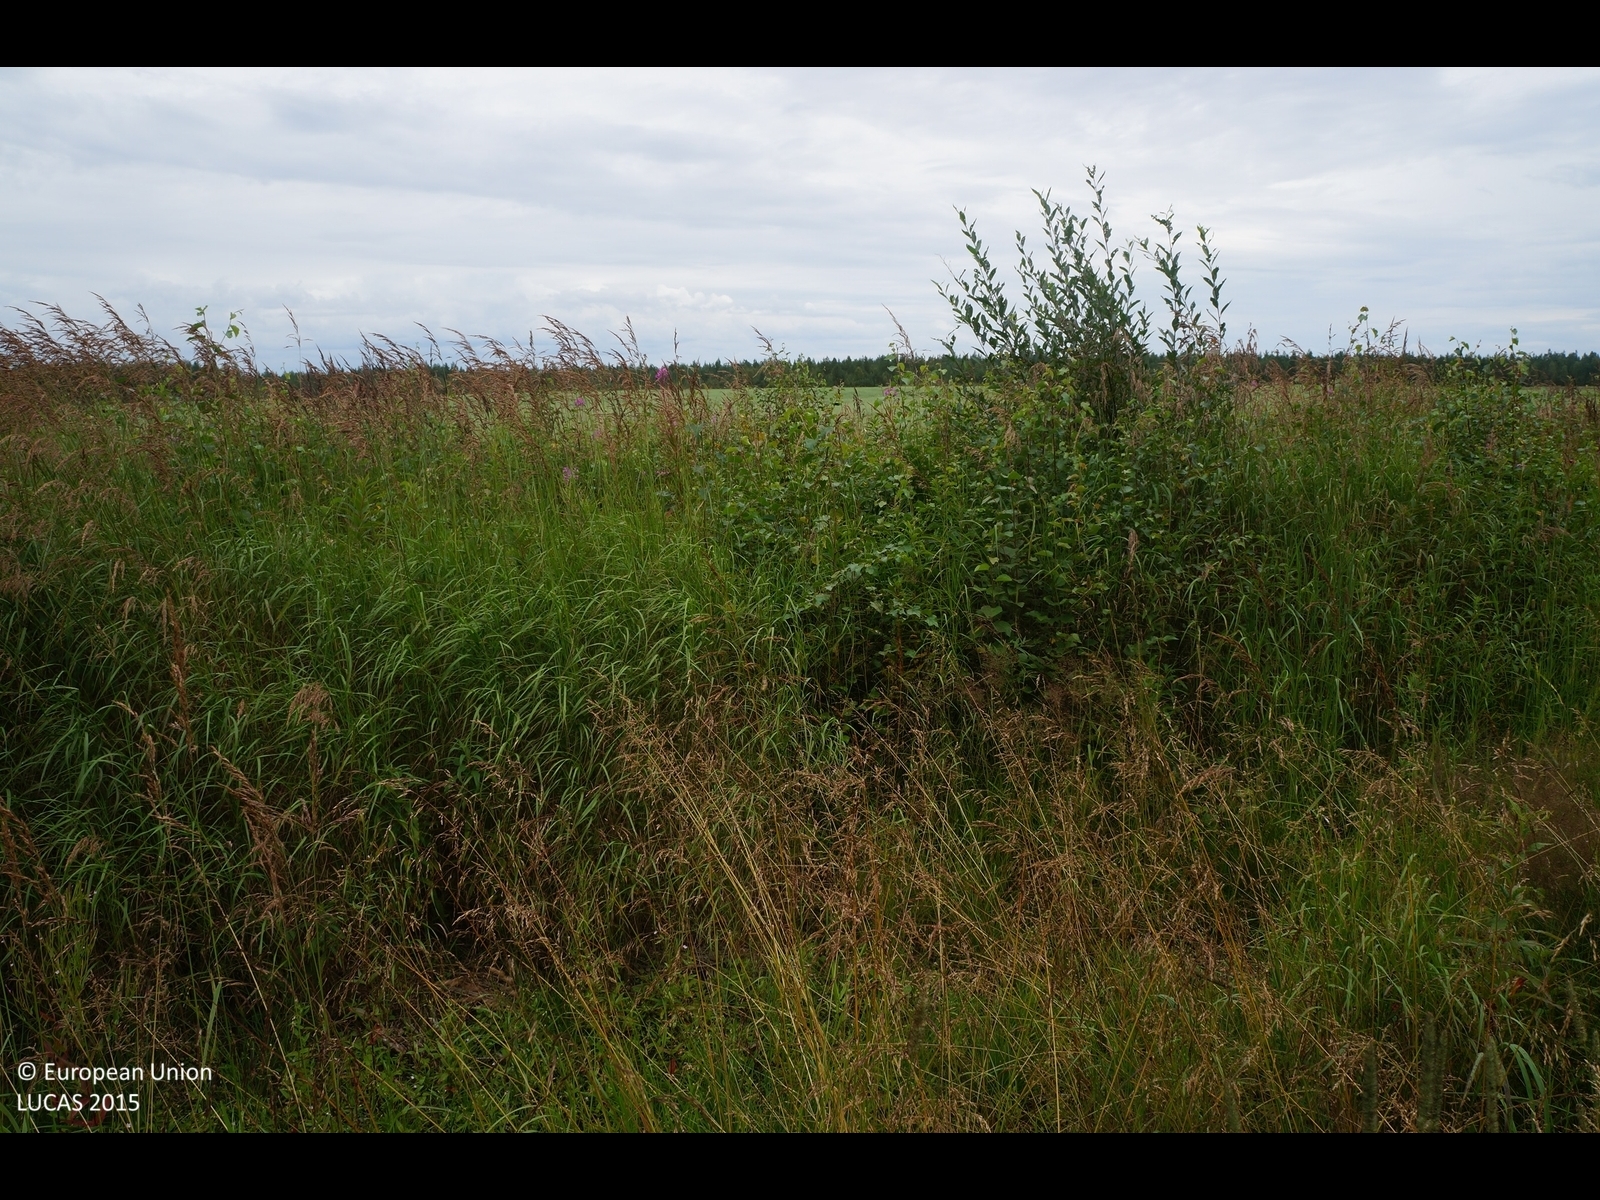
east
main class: Grassland
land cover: Grassland without tree/shrub cover
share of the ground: > 75 %
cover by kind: herbaceous plants 95 %, shrubs 5 %
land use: Electricity, gas and thermal power distribution
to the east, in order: Grassland without tree/shrub cover; Electric lines; Ditches and canals; Oats; Ditches and canals; Oats; Ditches and canals; Oats; Ditches and canals
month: August
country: FI
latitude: 64.7528
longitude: 24.9736
